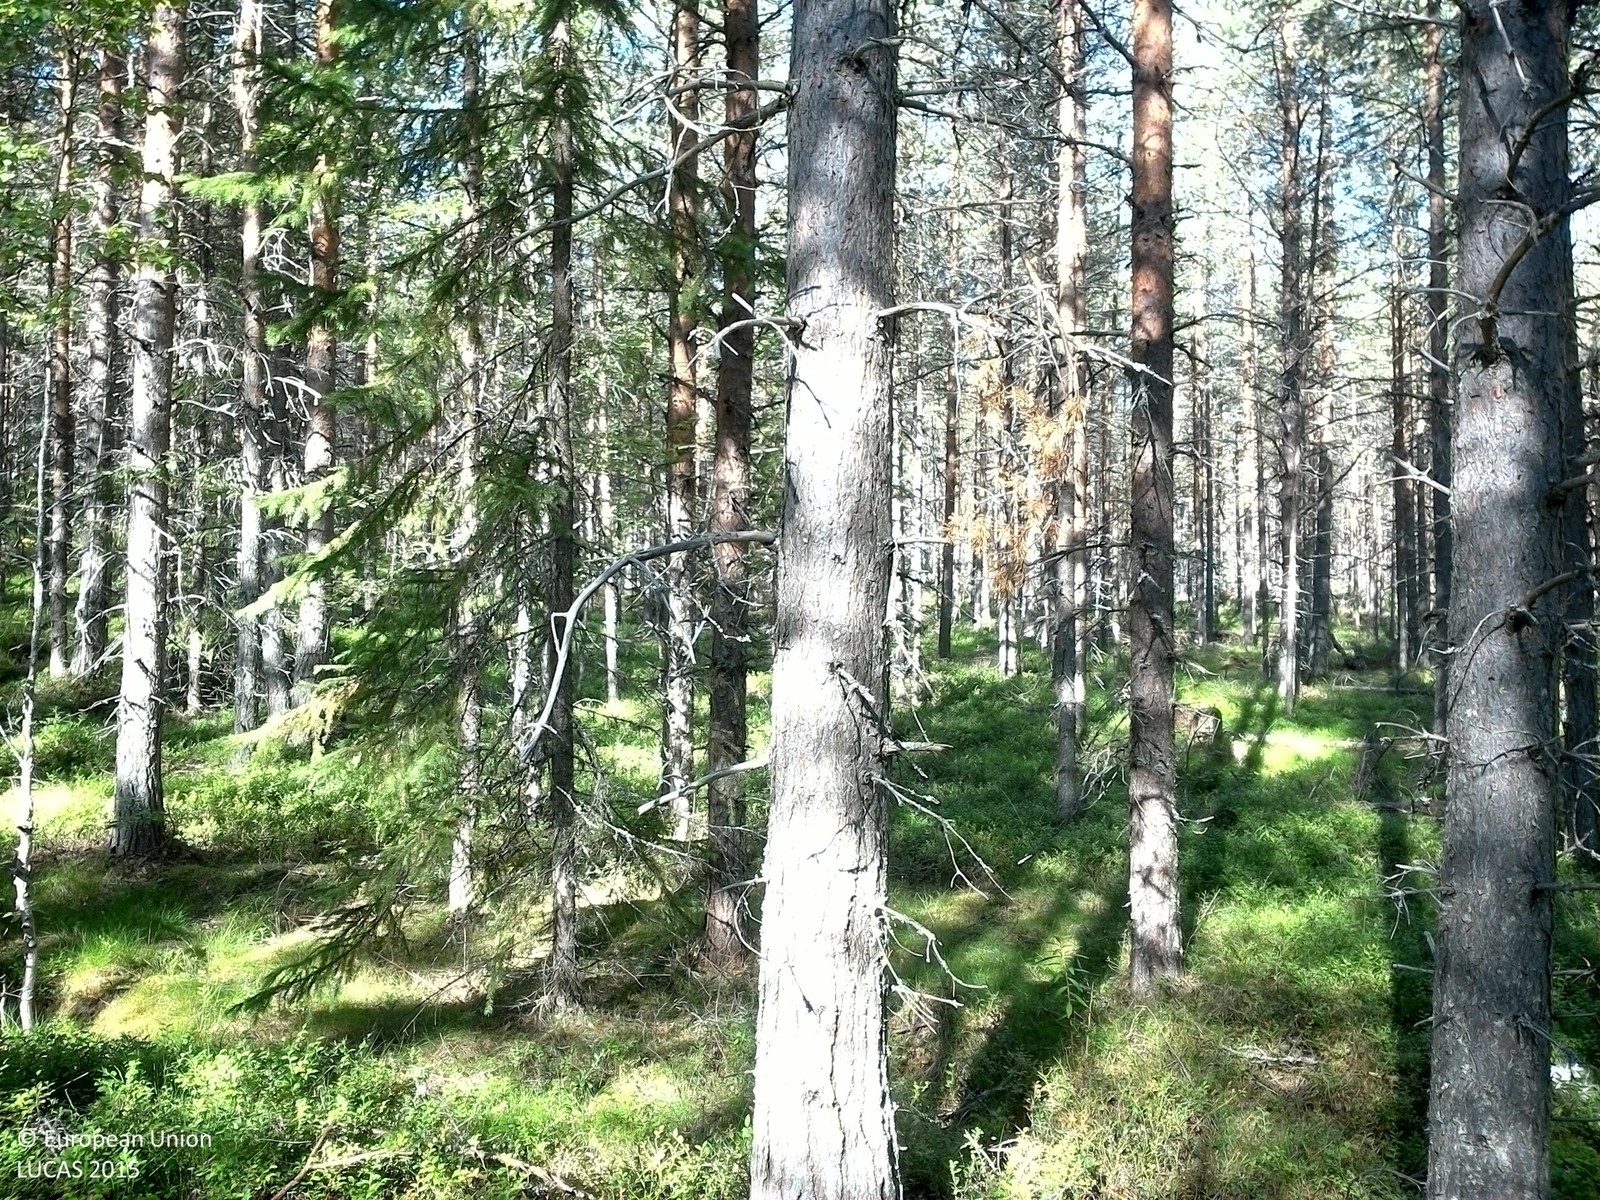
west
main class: Woodland
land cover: Pine dominated coniferous woodland
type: boreal forest
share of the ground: > 75 %
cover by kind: coniferous forest trees 75 %, shrubs 25 %
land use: Forestry
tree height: > 5 m
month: August
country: SE
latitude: 63.6601
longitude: 17.8315
